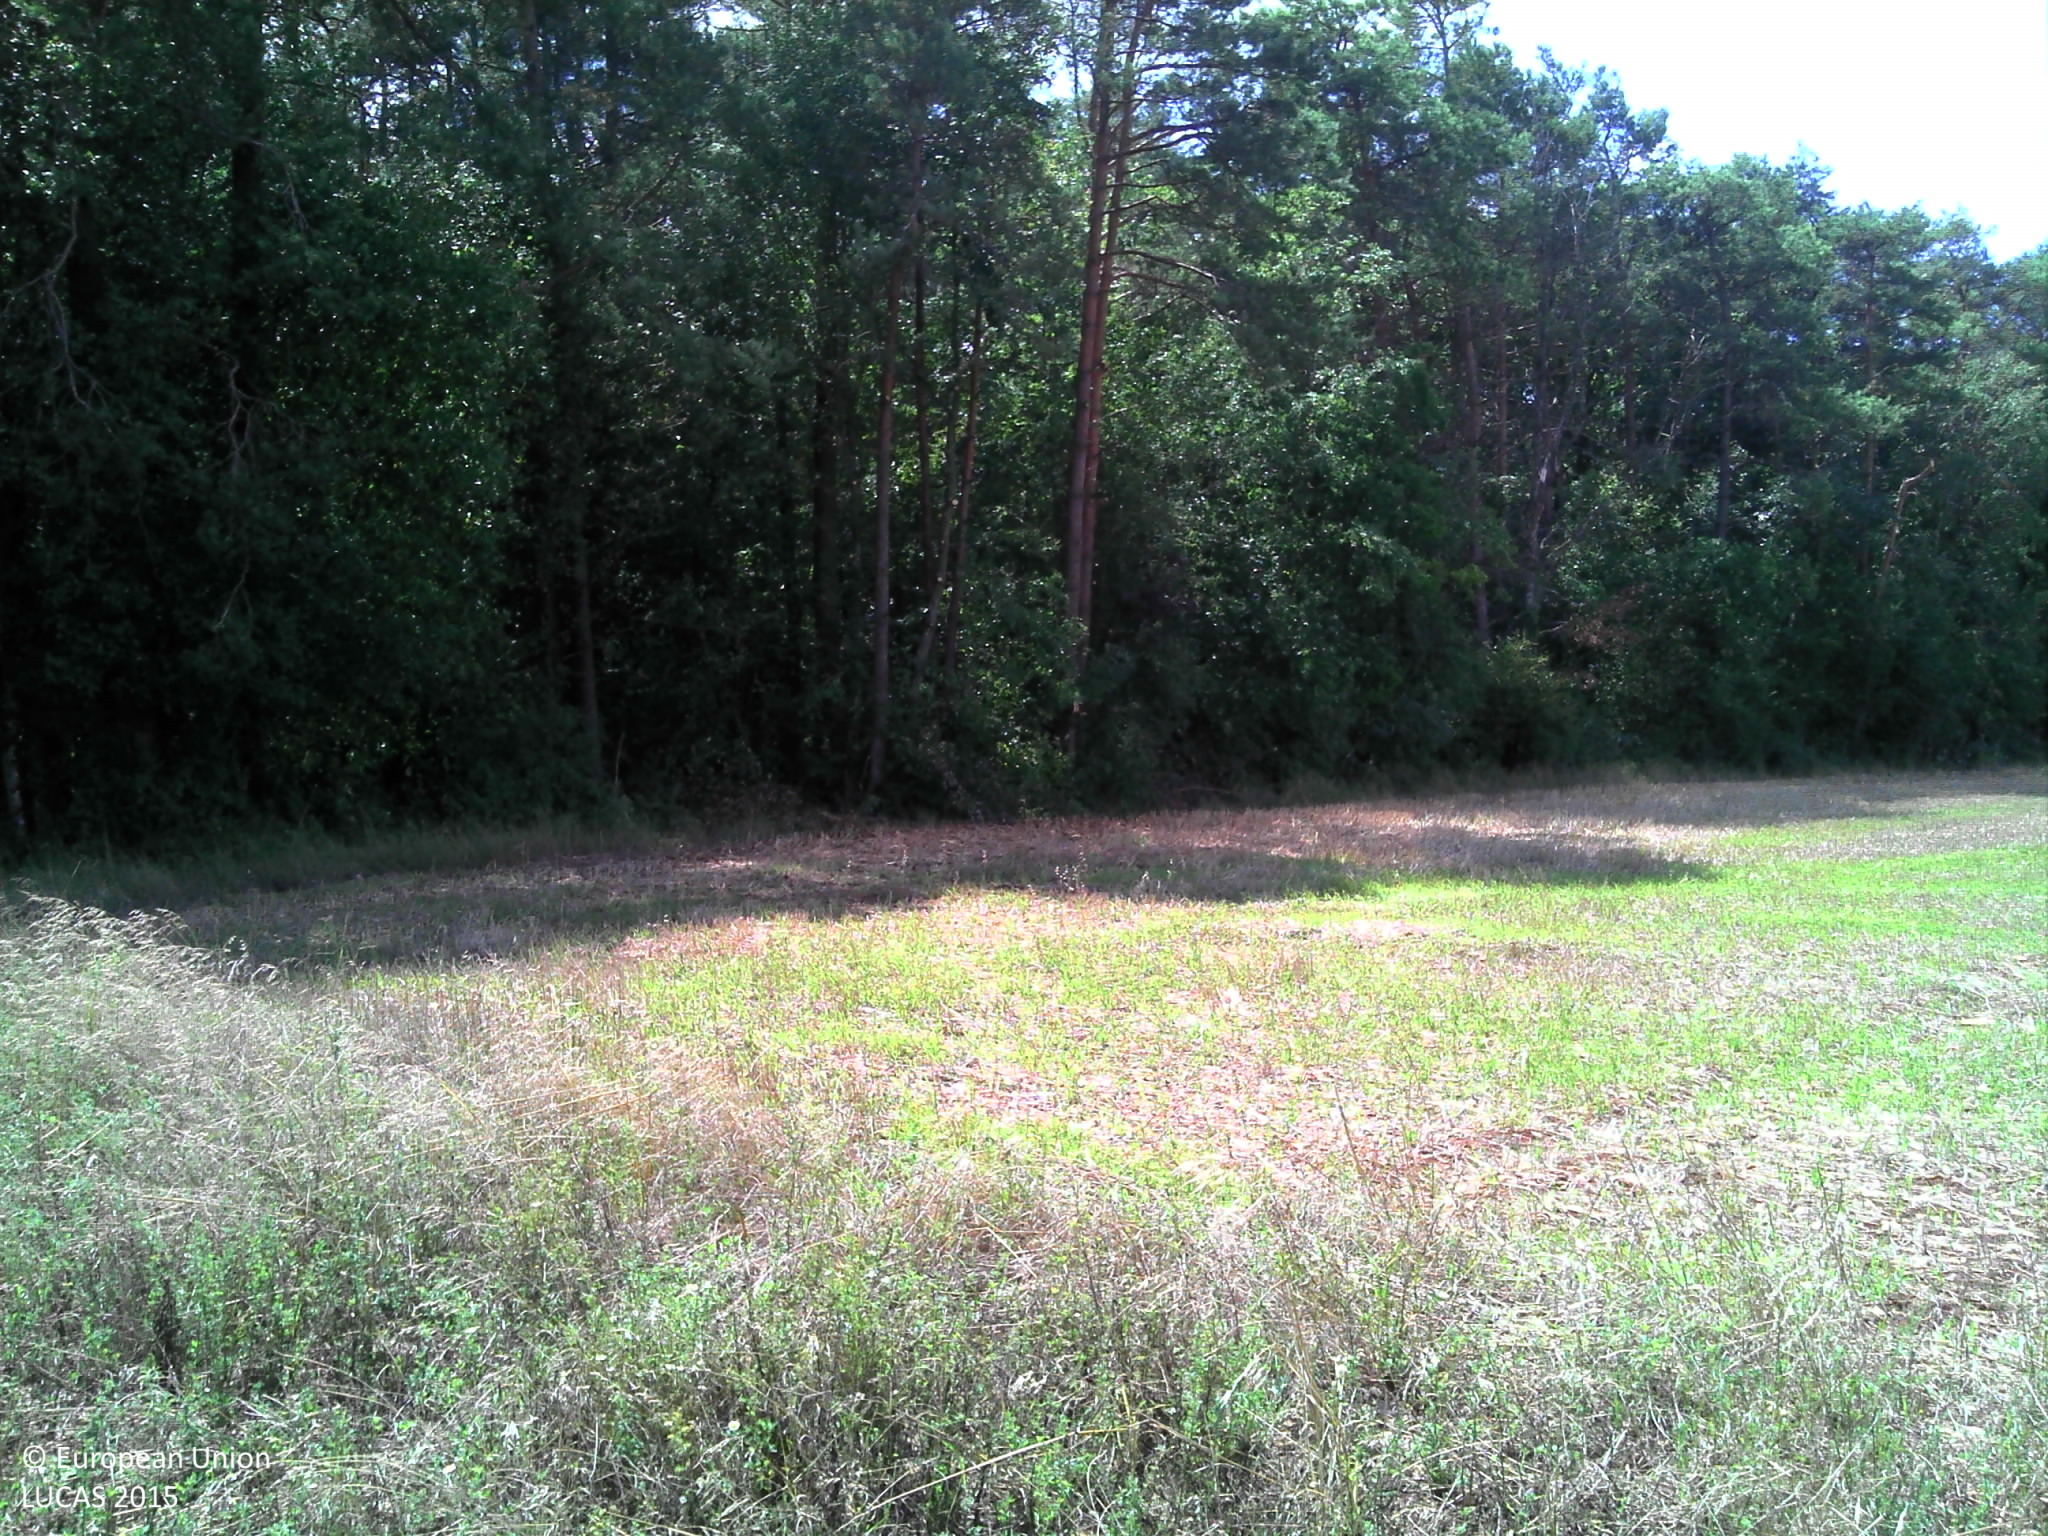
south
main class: Cropland
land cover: Lucerne
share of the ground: > 75 %
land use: Agriculture (excluding fallow land and kitchen gardens)
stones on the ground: 10 - 25 %
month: August
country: FR
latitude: 47.8831
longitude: 4.7703
